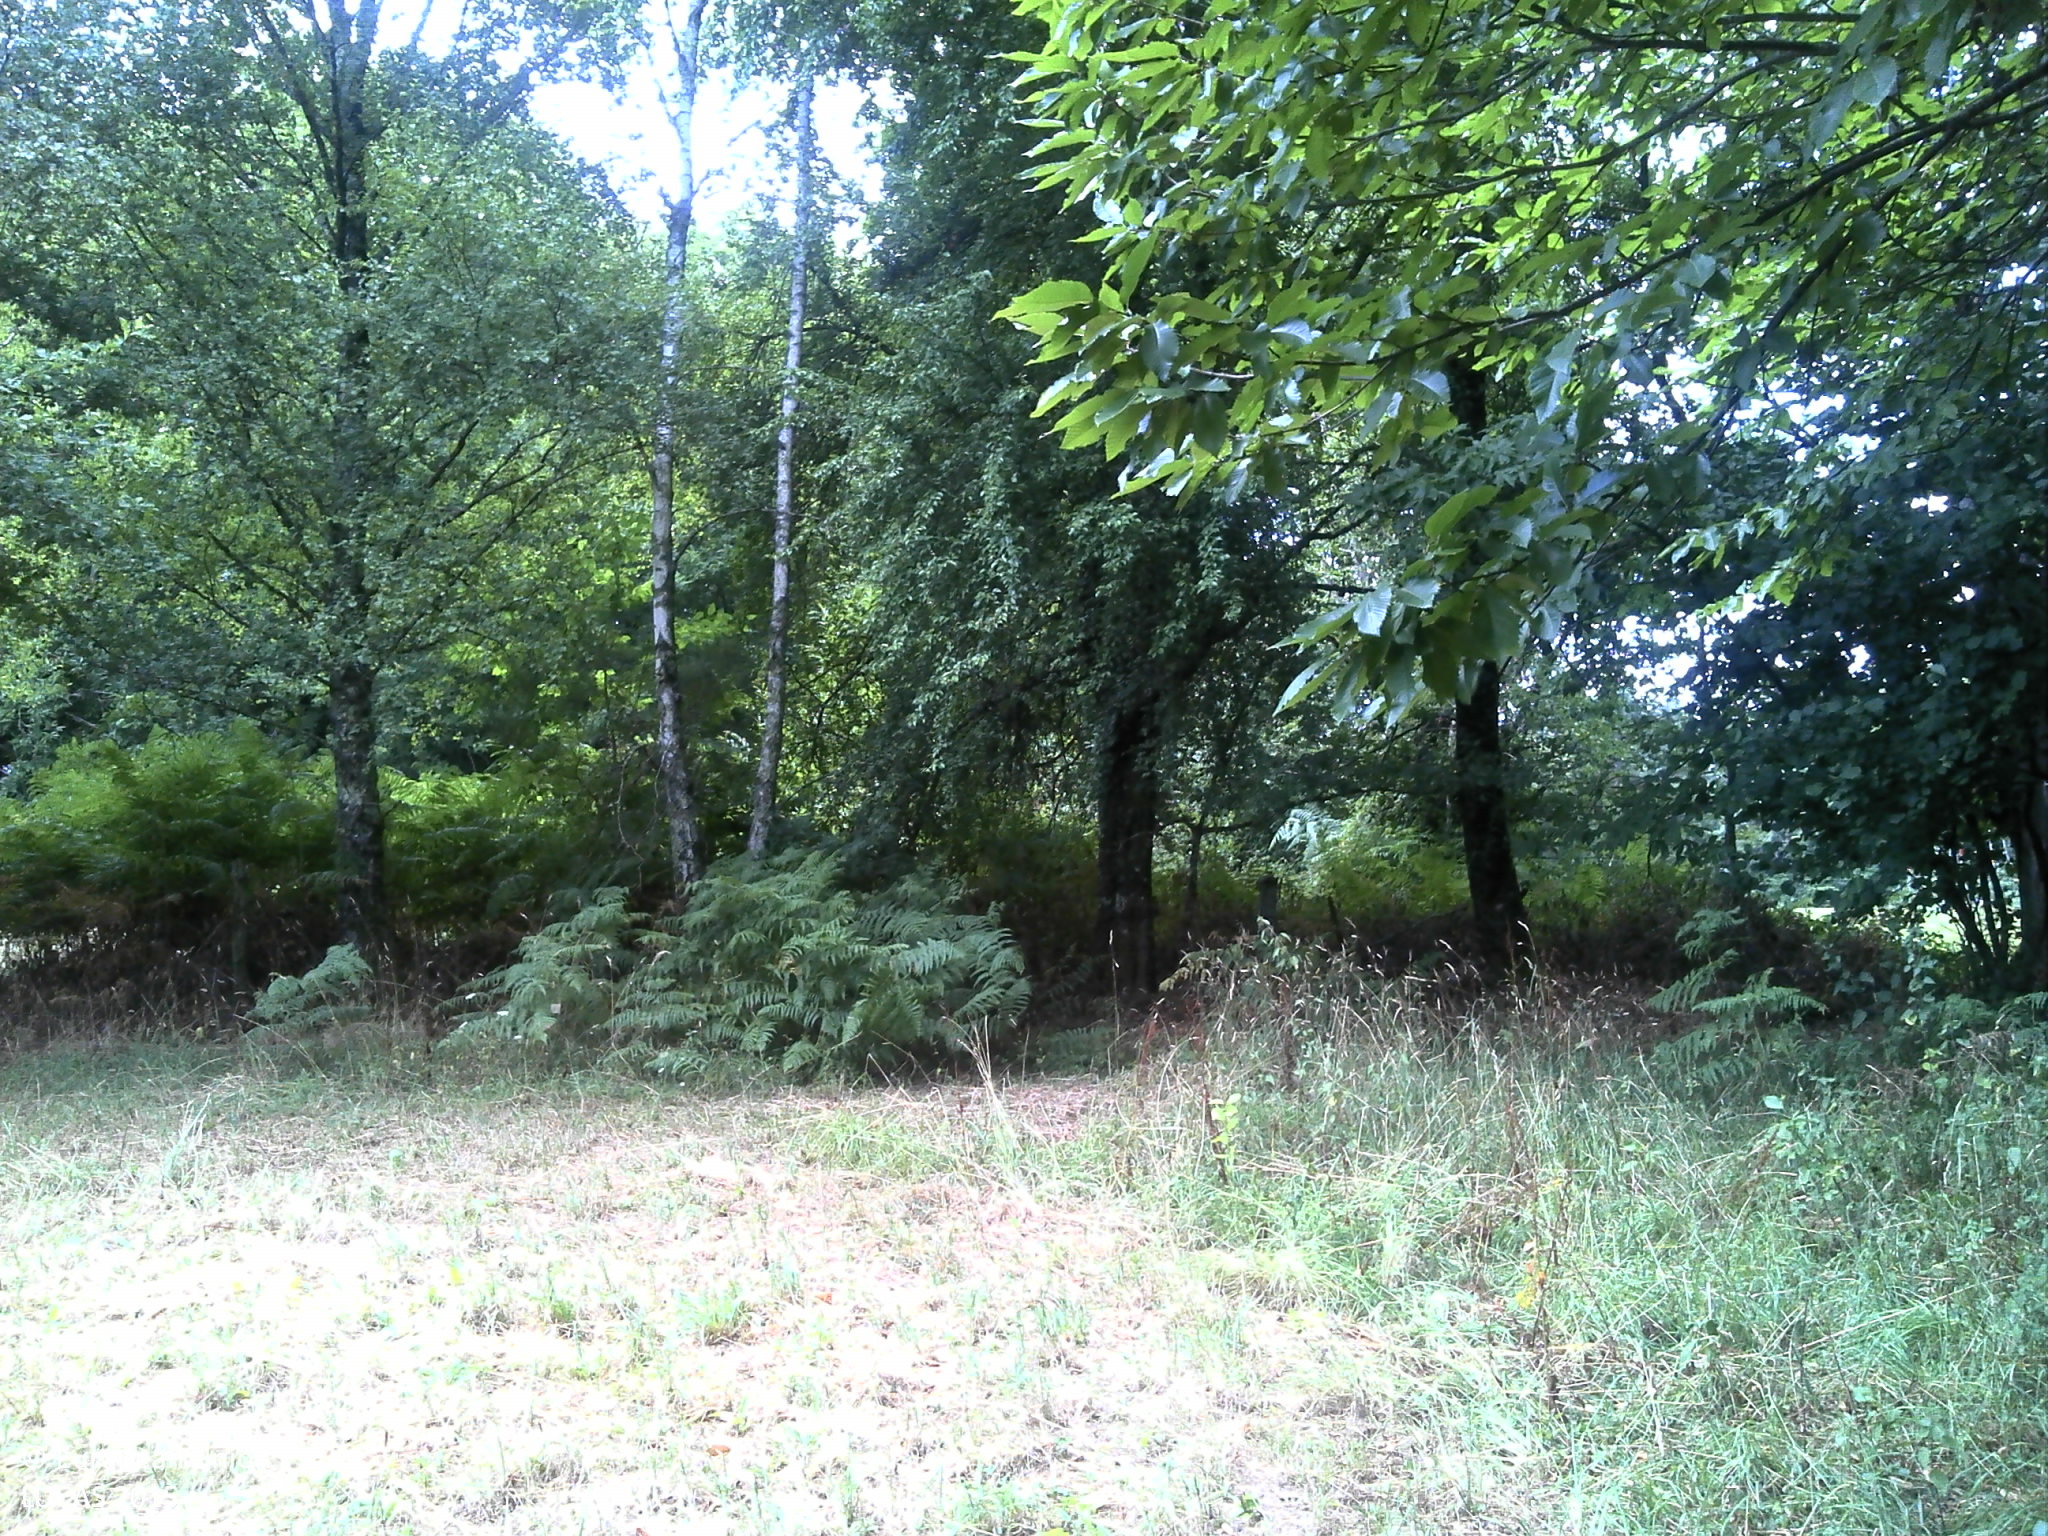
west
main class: Grassland
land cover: Grassland without tree/shrub cover
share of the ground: > 75 %
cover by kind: herbaceous plants 90 %, unconsolidated bare surface 10 %
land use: Agriculture (excluding fallow land and kitchen gardens)
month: July
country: FR
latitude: 44.9790
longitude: 1.9456
